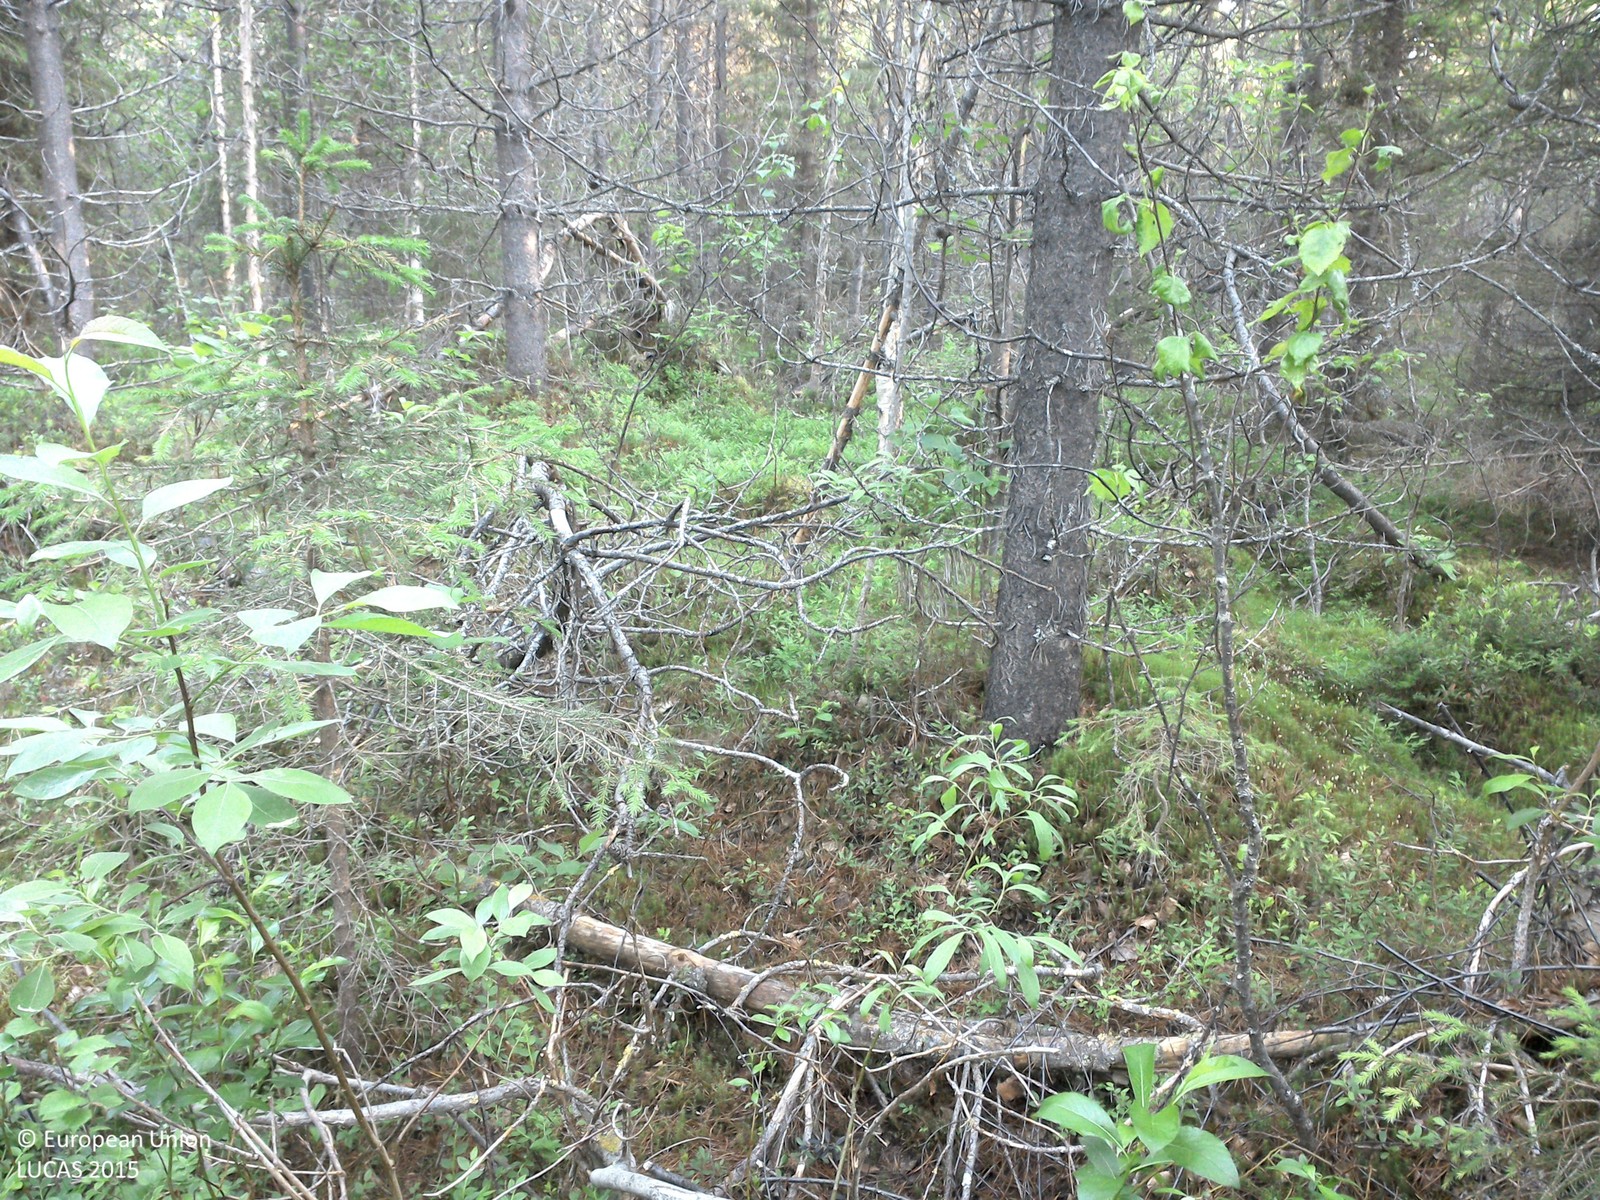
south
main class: Woodland
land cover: Pine dominated mixed woodland
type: exotic forest
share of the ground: 25 - 50 %
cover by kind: shrubs 55 %, coniferous forest trees 25 %, broadleaved forest trees 10 %, lichens and mosses 10 %
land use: Forestry
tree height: > 5 m
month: July
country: SE
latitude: 66.7564
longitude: 23.5833
